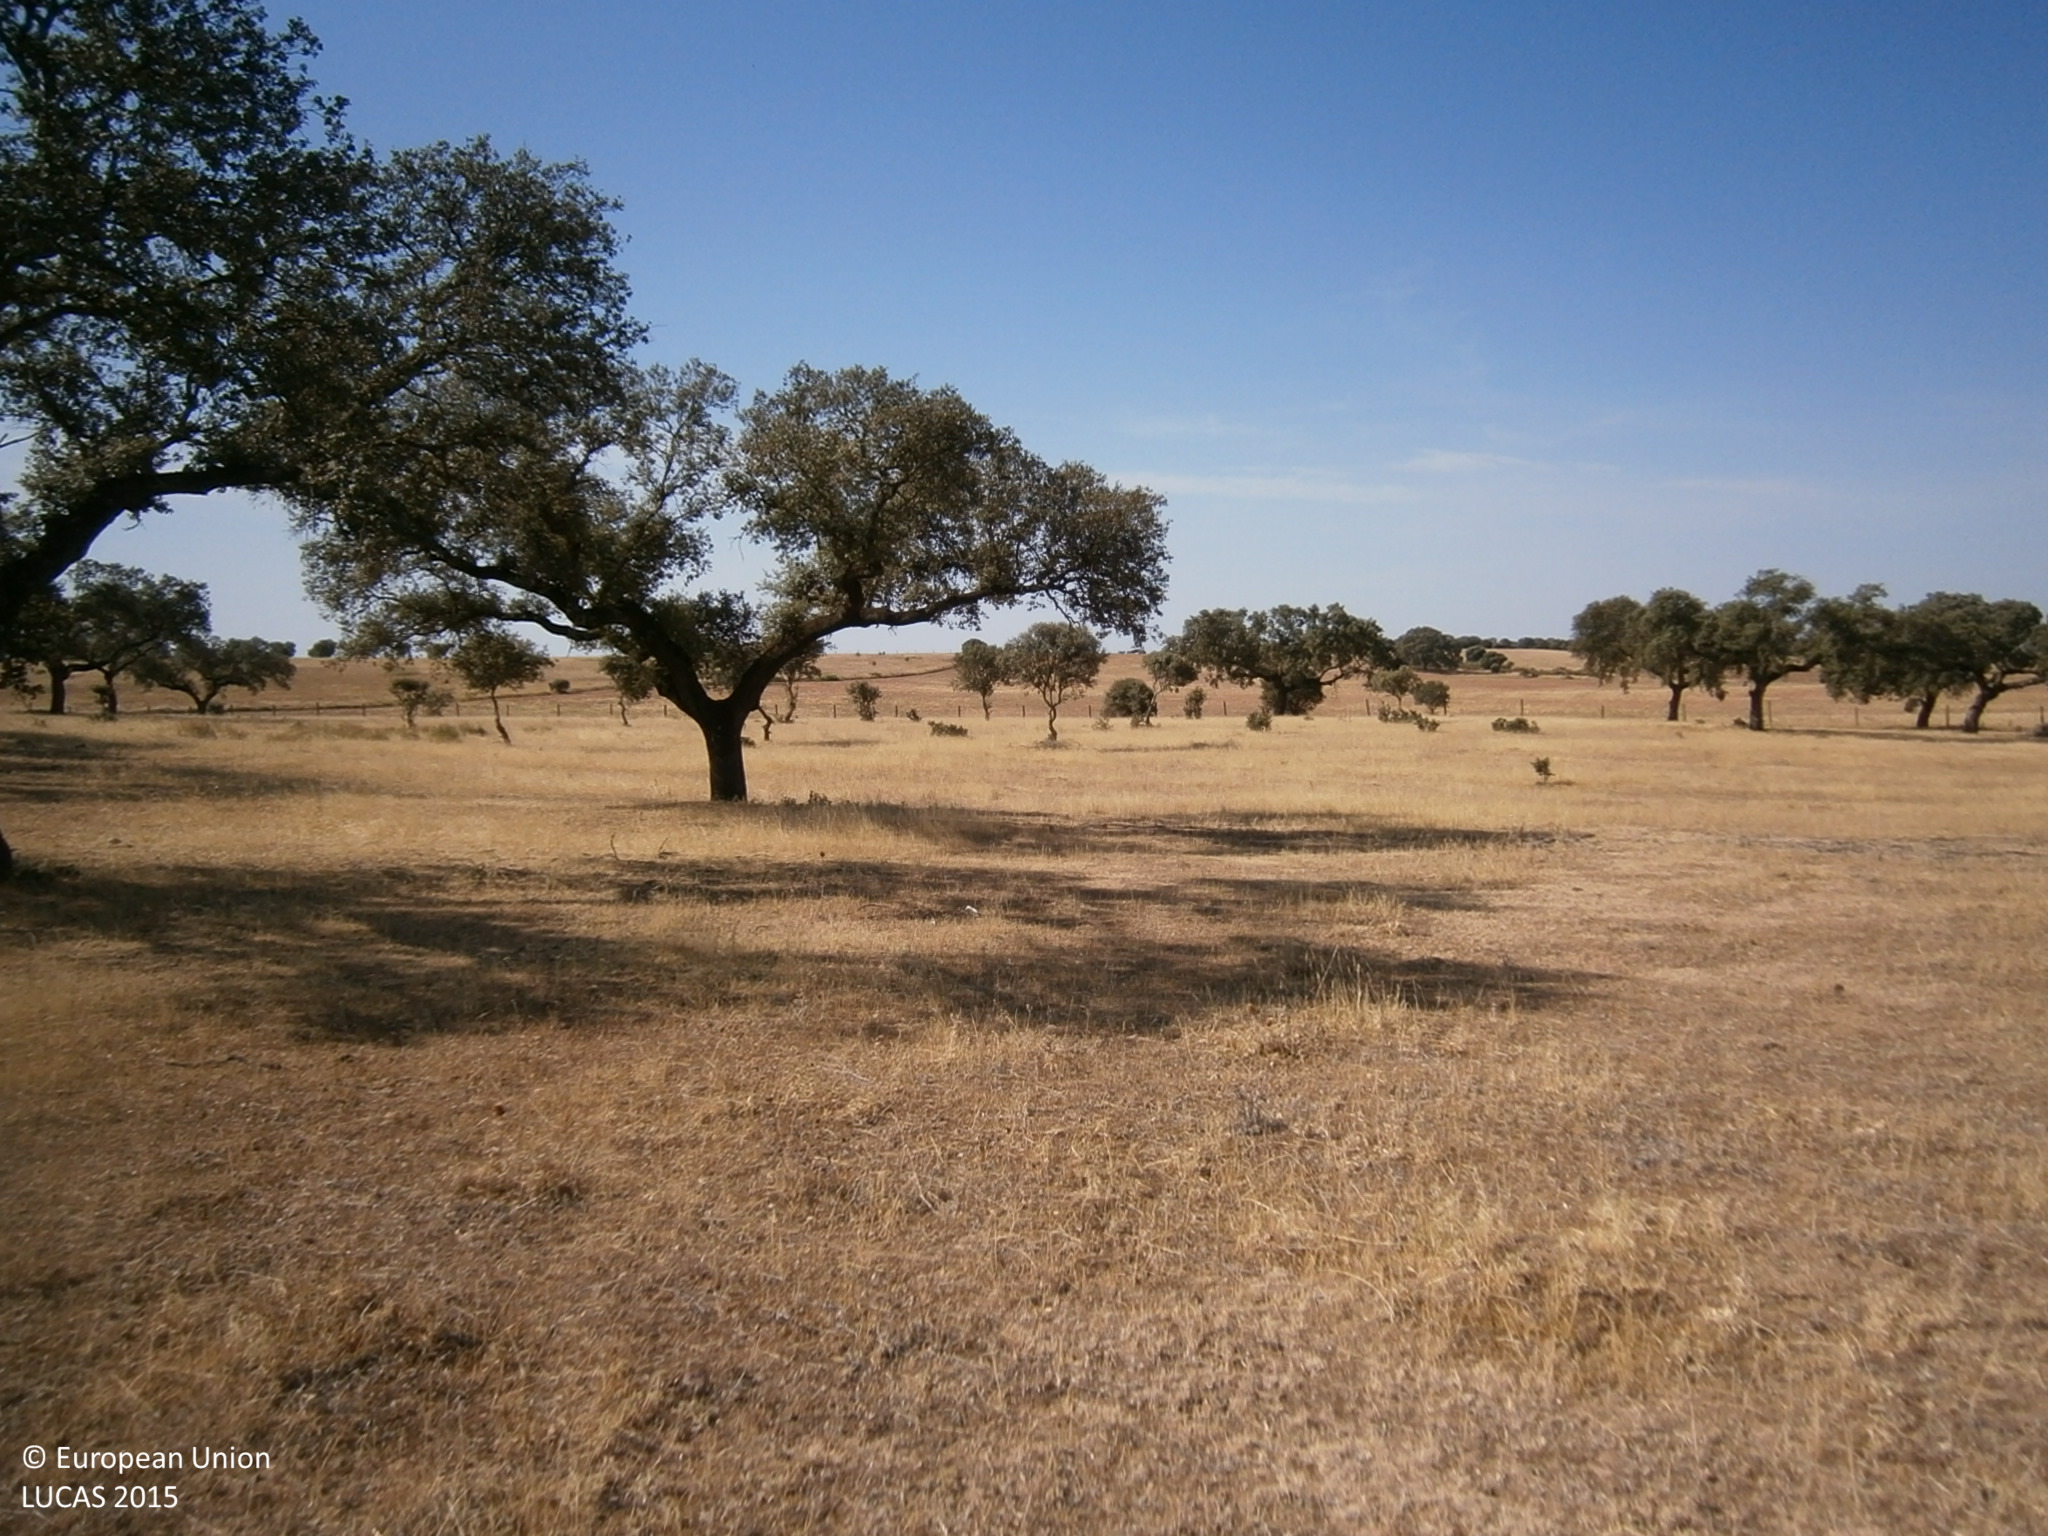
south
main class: Woodland
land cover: Broadleaved woodland
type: broadleaved evergreen forest
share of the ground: 10 - 25 %
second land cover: Spontaneously vegetated surfaces
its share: 50 - 75 %
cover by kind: herbaceous plants 65 %, broadleaved forest trees 25 %, unconsolidated bare surface 10 %
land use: Forestry
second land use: Agriculture (excluding fallow land and kitchen gardens)
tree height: > 5 m
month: July
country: ES
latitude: 39.0389
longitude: -6.7389
